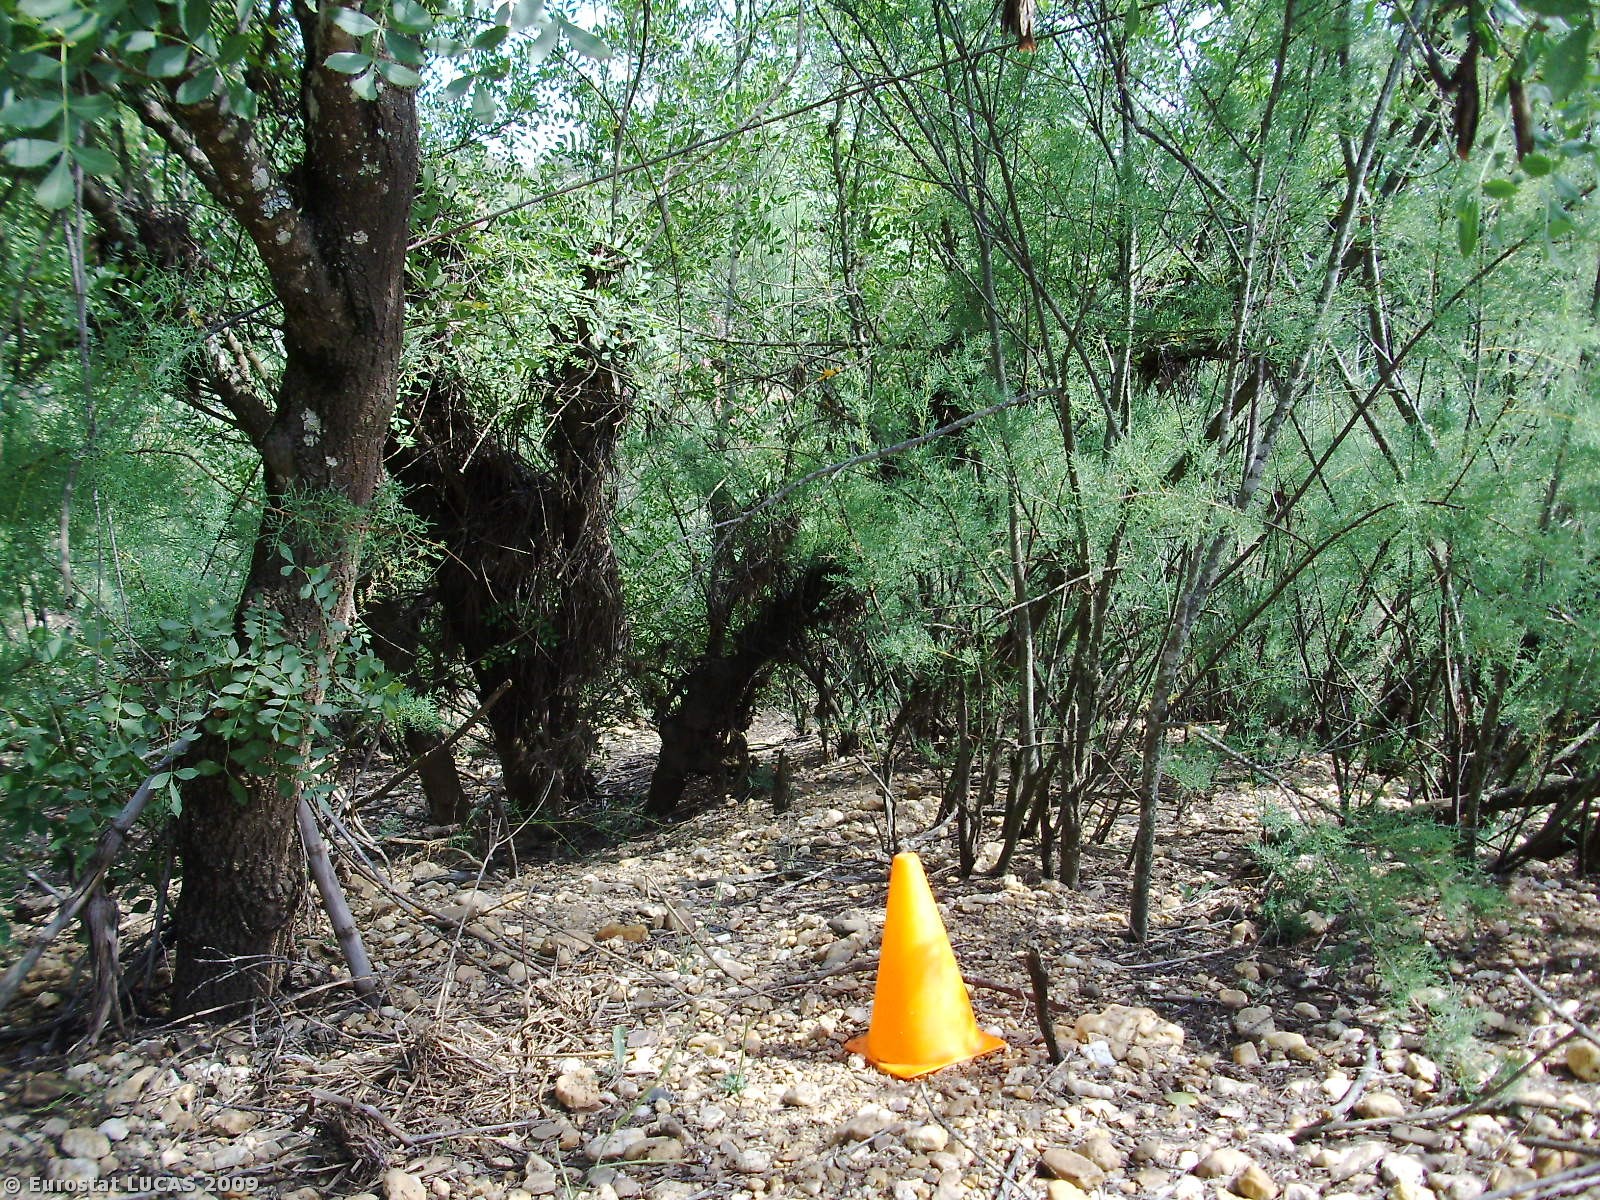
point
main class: Woodland
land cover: Mixed woodland
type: floodplain forest
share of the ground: > 75 %
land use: Unused
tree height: > 5 m
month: June
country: PT
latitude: 38.0342
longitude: -8.3722
